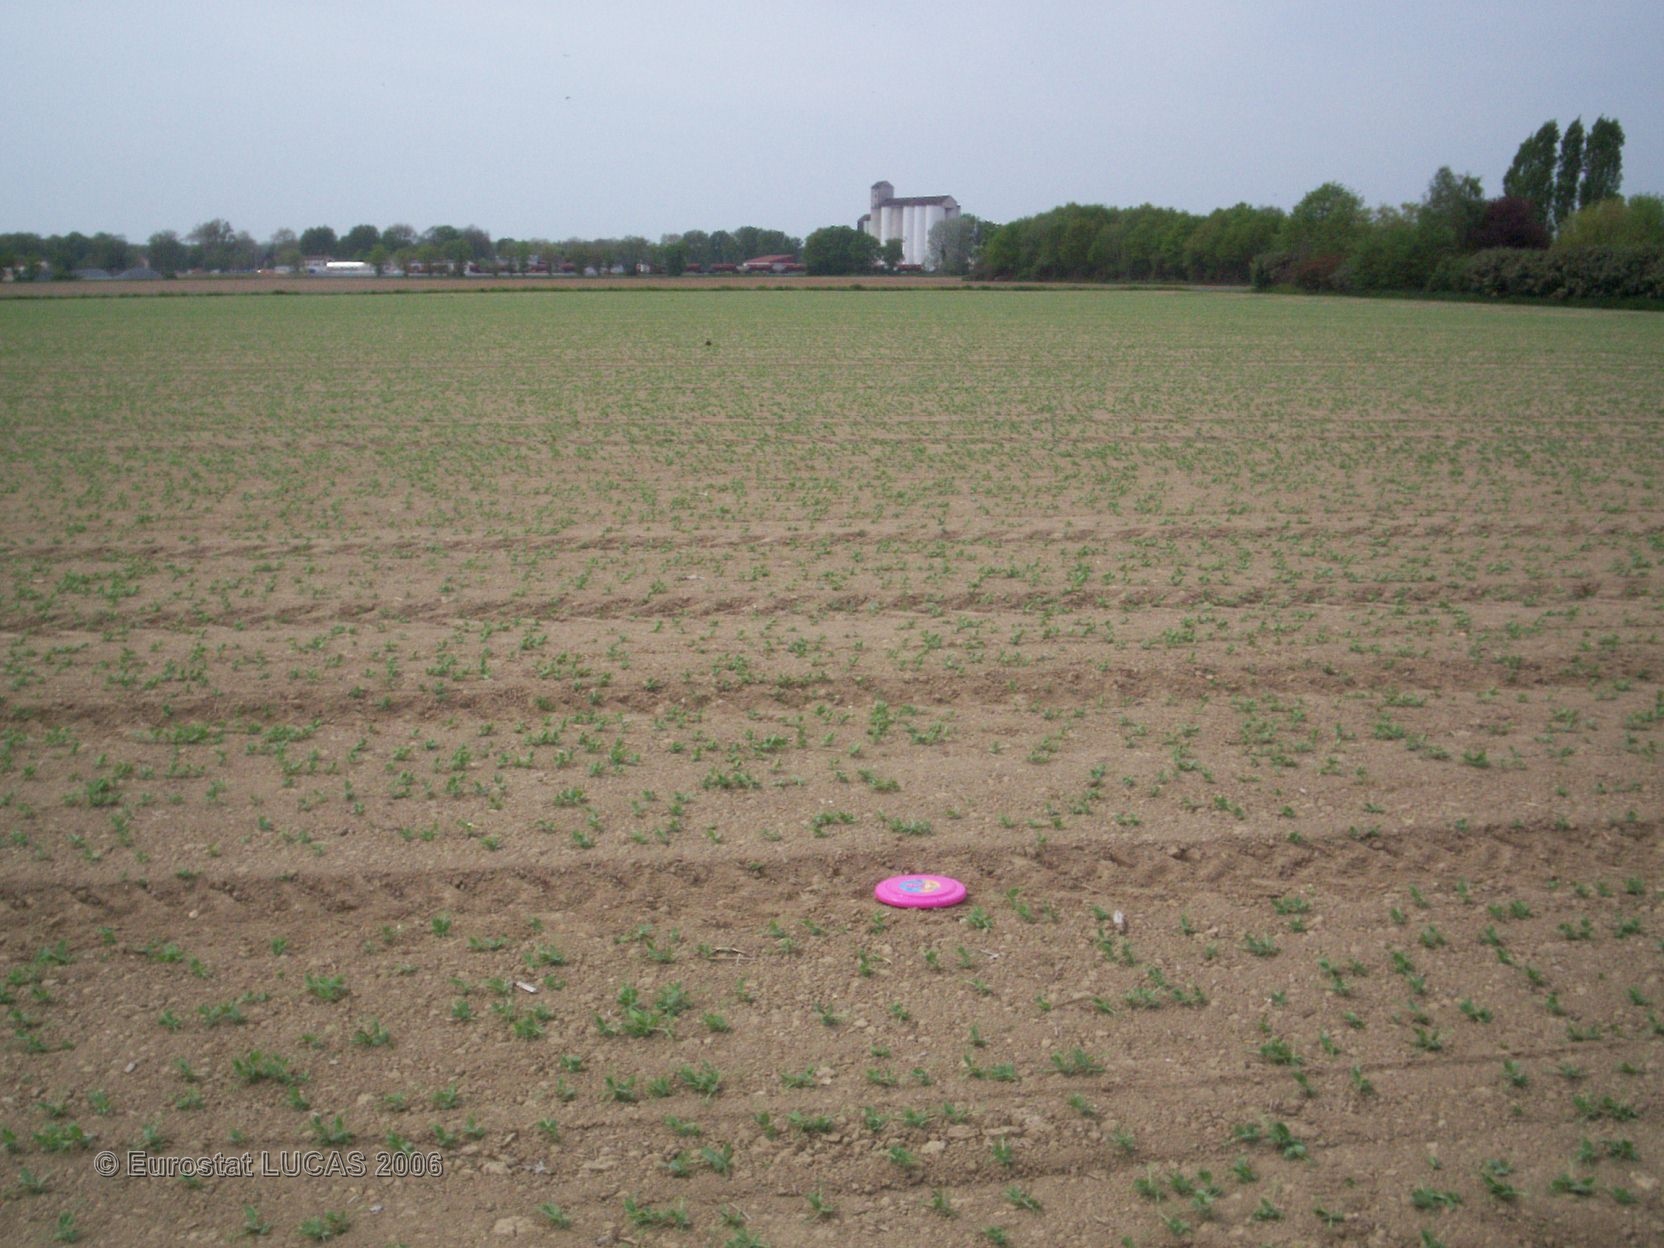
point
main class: Cropland
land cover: Dry pulses
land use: Agriculture (excluding fallow land and kitchen gardens)
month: May
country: FR
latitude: 48.7337
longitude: 2.8800
